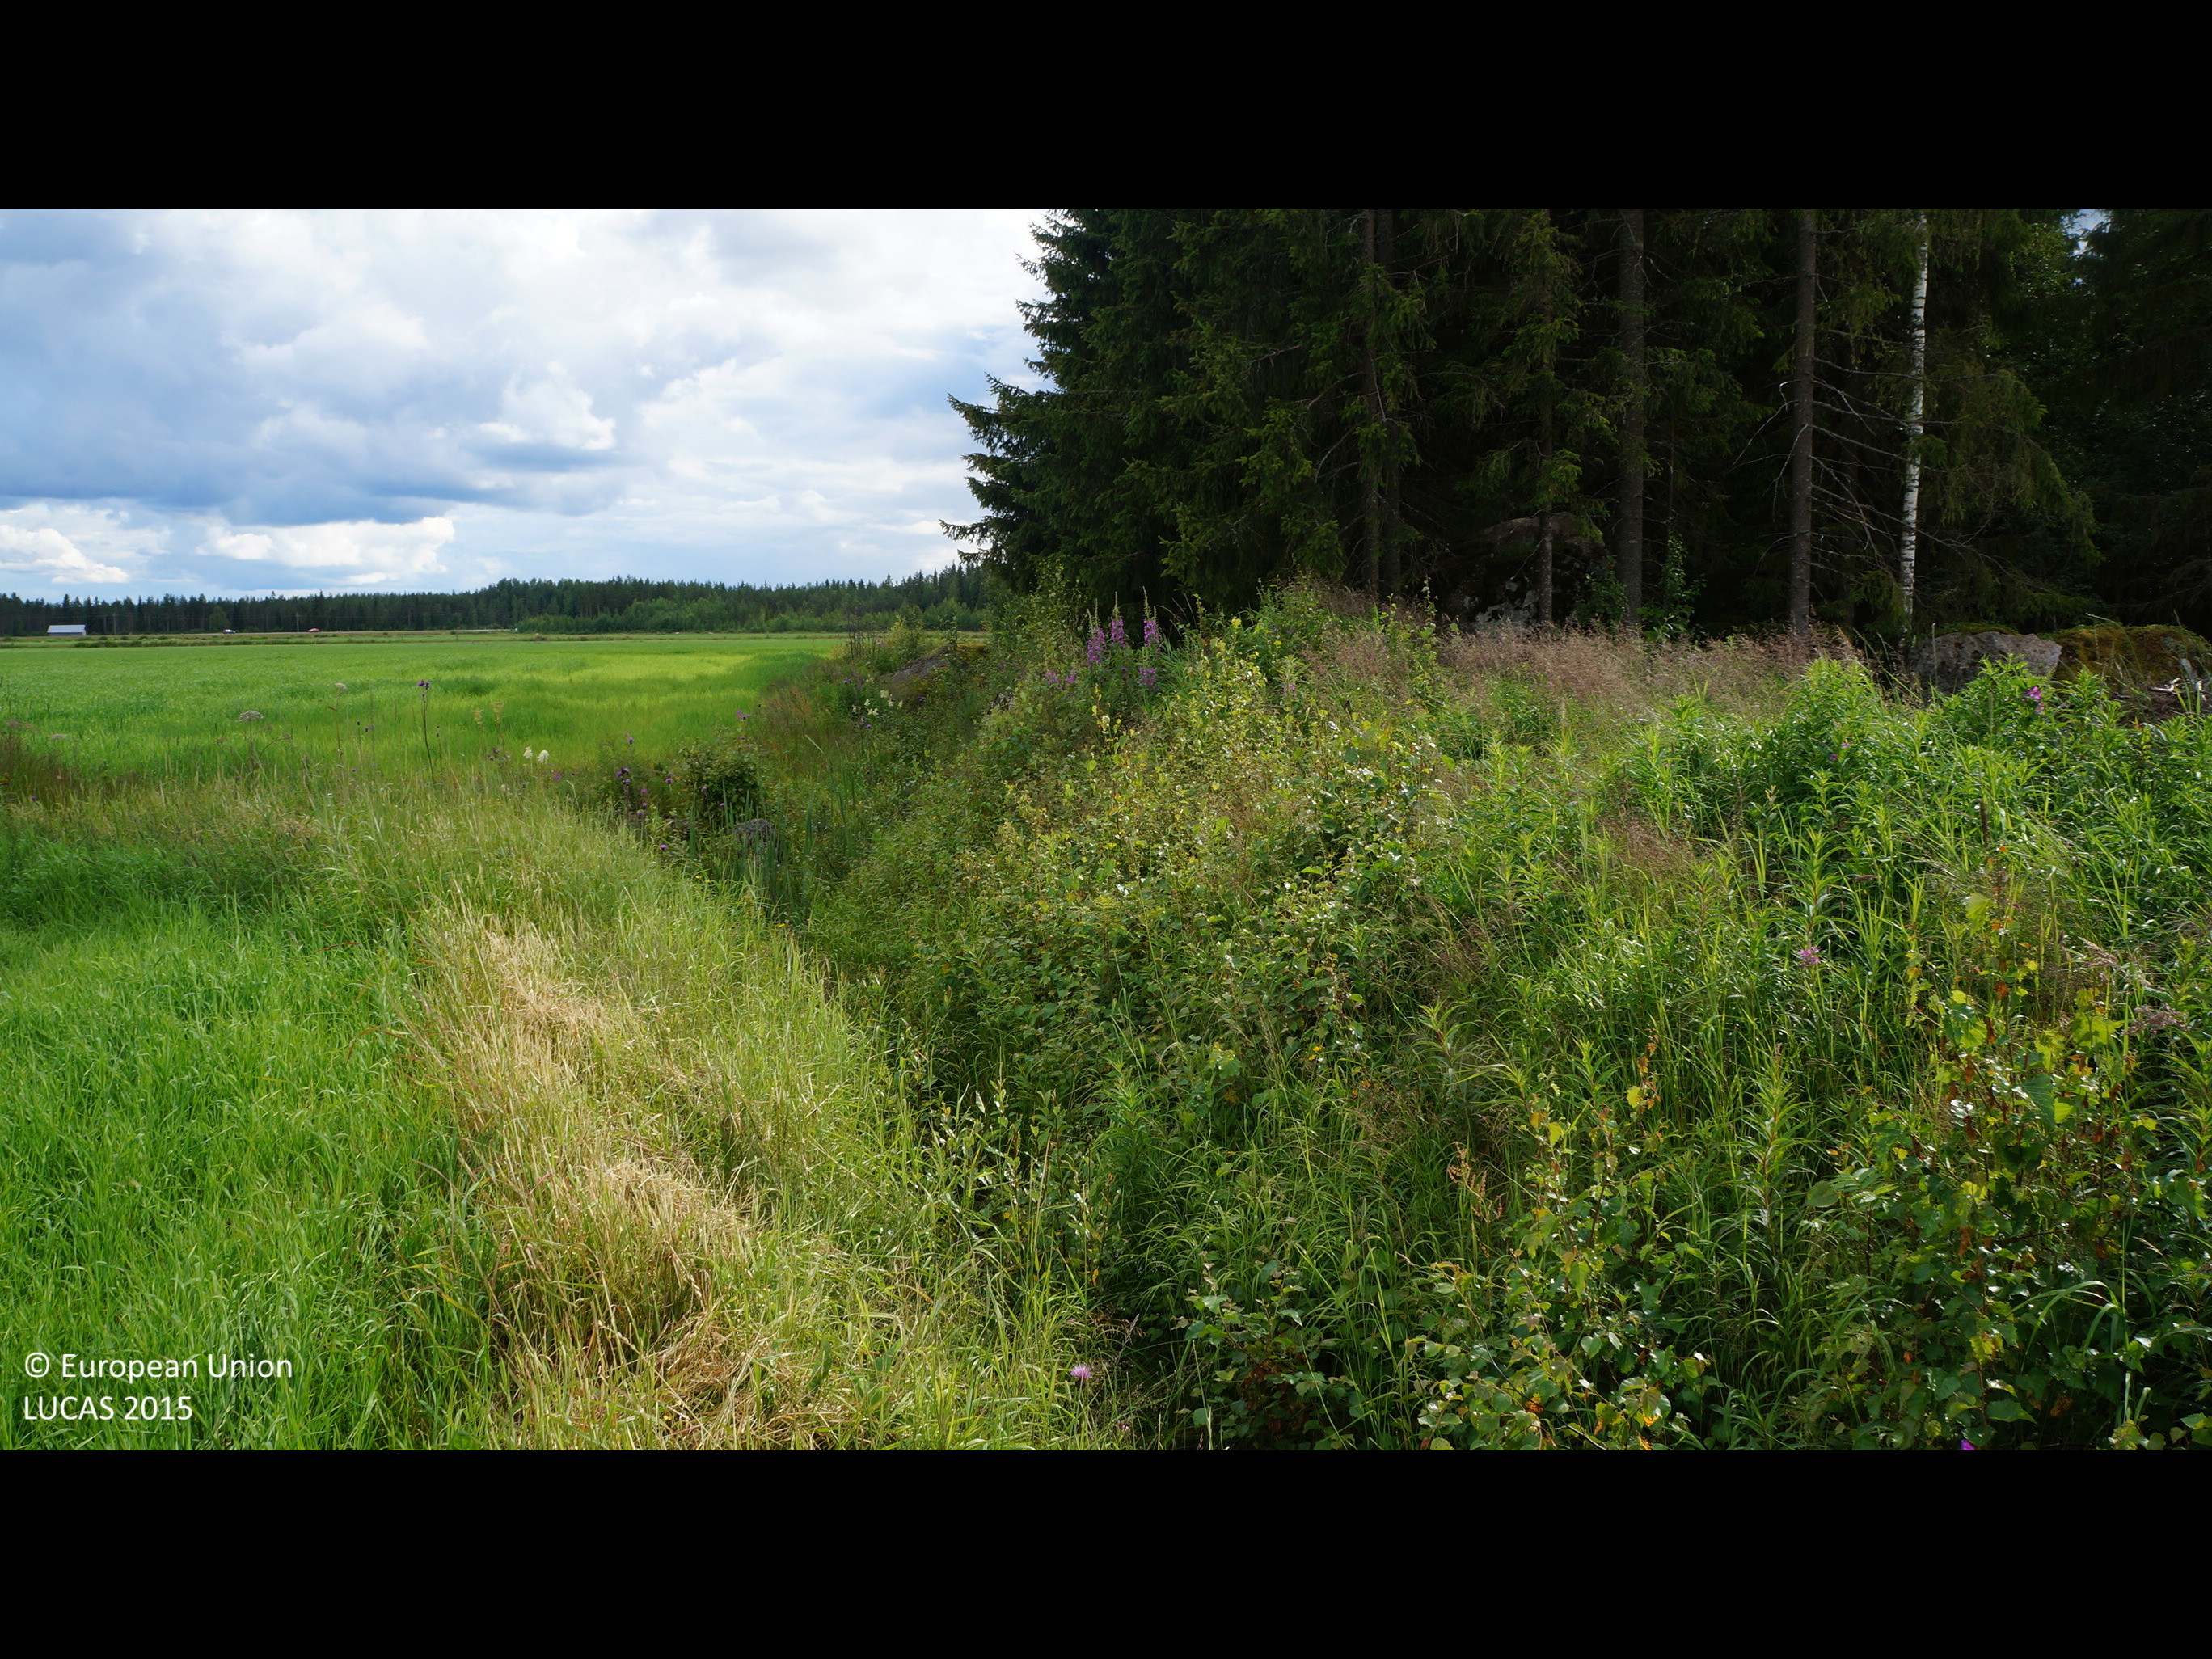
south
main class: Cropland
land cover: Temporary grasslands
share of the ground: > 75 %
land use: Agriculture (excluding fallow land and kitchen gardens)
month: July
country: FI
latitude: 63.9739
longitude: 24.2255
